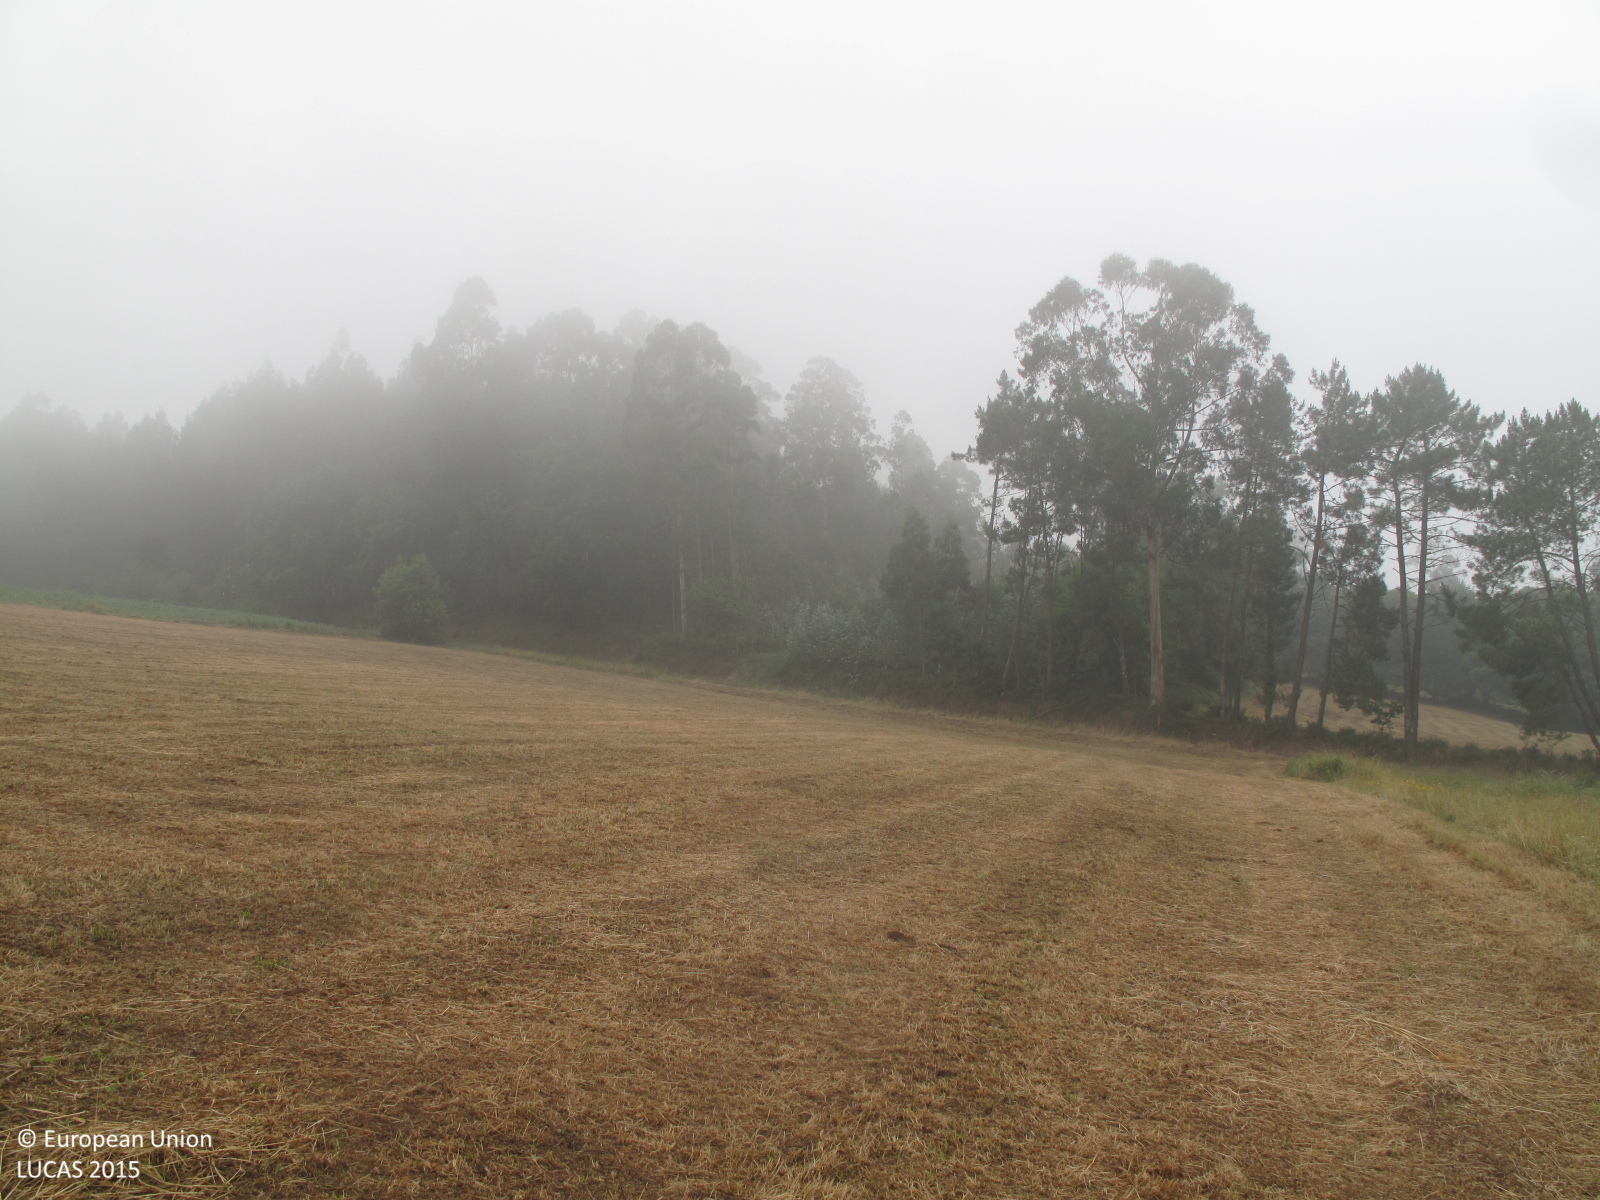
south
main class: Grassland
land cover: Grassland without tree/shrub cover
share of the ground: > 75 %
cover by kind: herbaceous plants 80 %, unconsolidated bare surface 20 %
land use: Agriculture (excluding fallow land and kitchen gardens)
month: June
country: ES
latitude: 43.1775
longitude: -8.2452
